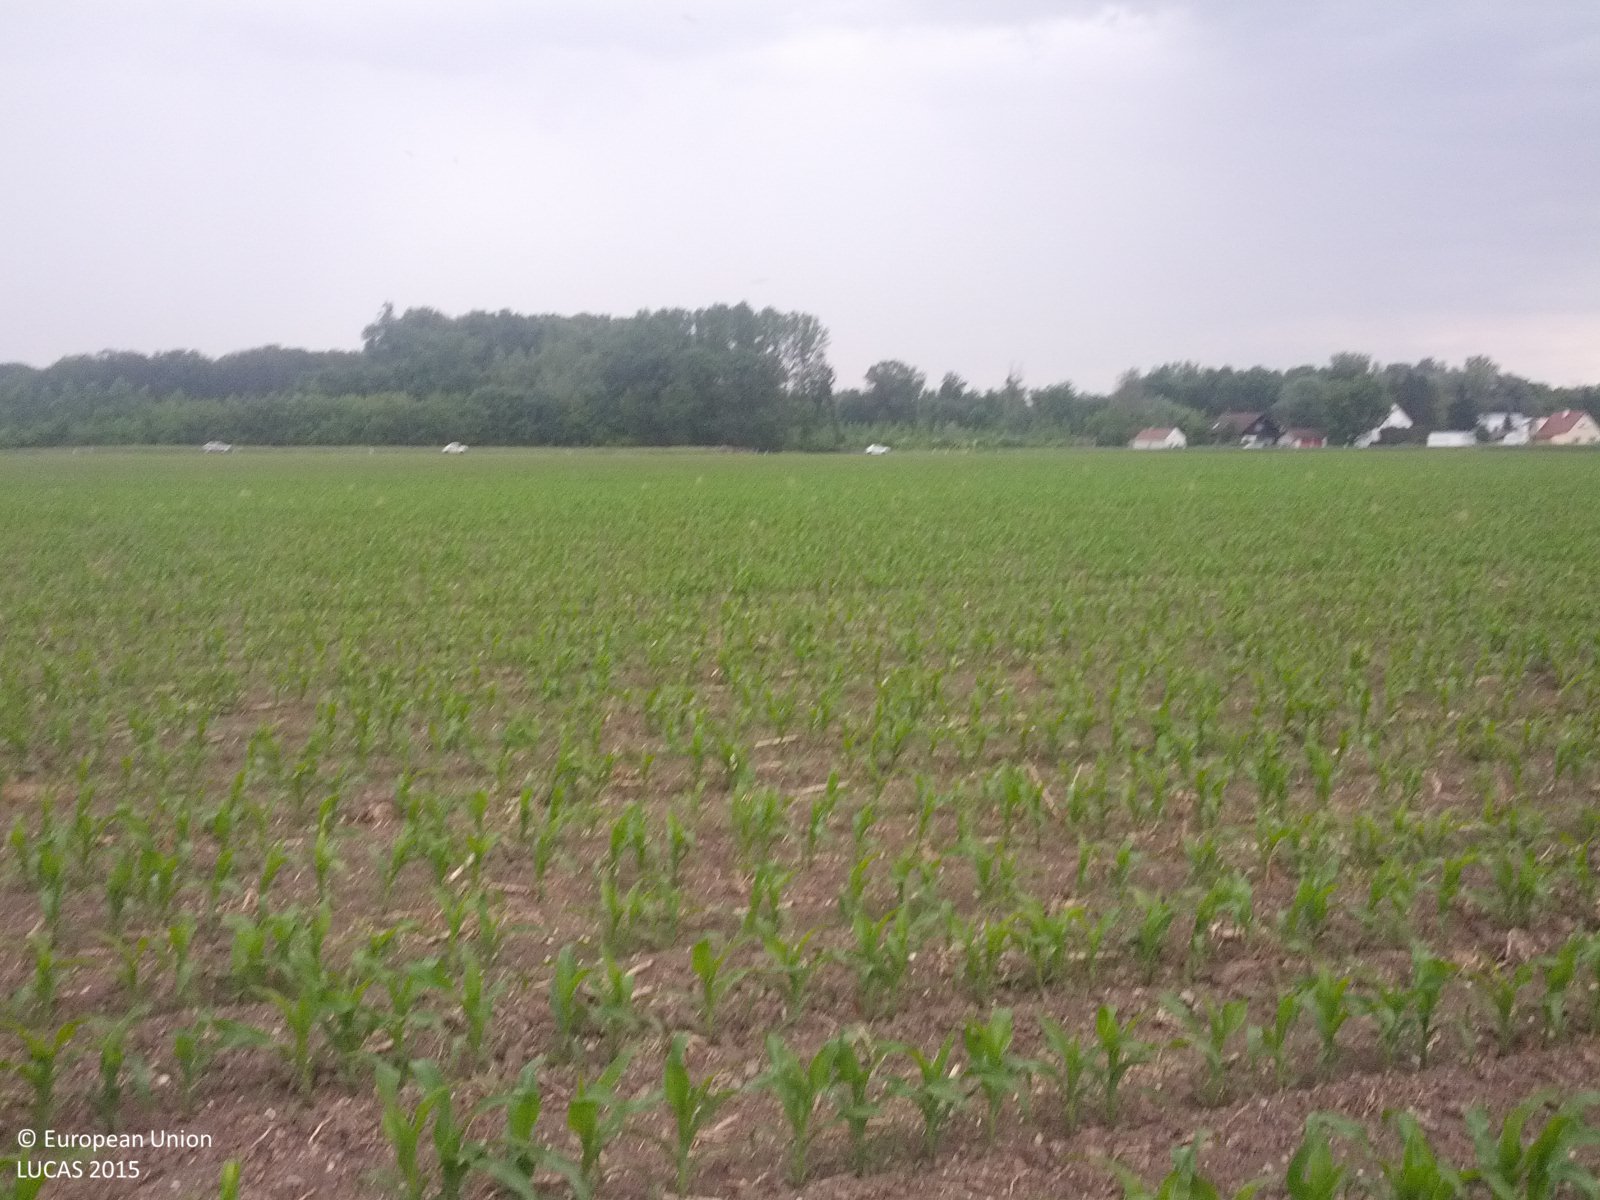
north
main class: Cropland
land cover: Durum wheat
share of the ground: > 75 %
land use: Agriculture (excluding fallow land and kitchen gardens)
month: May
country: AT
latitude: 48.3260
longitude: 16.0872
